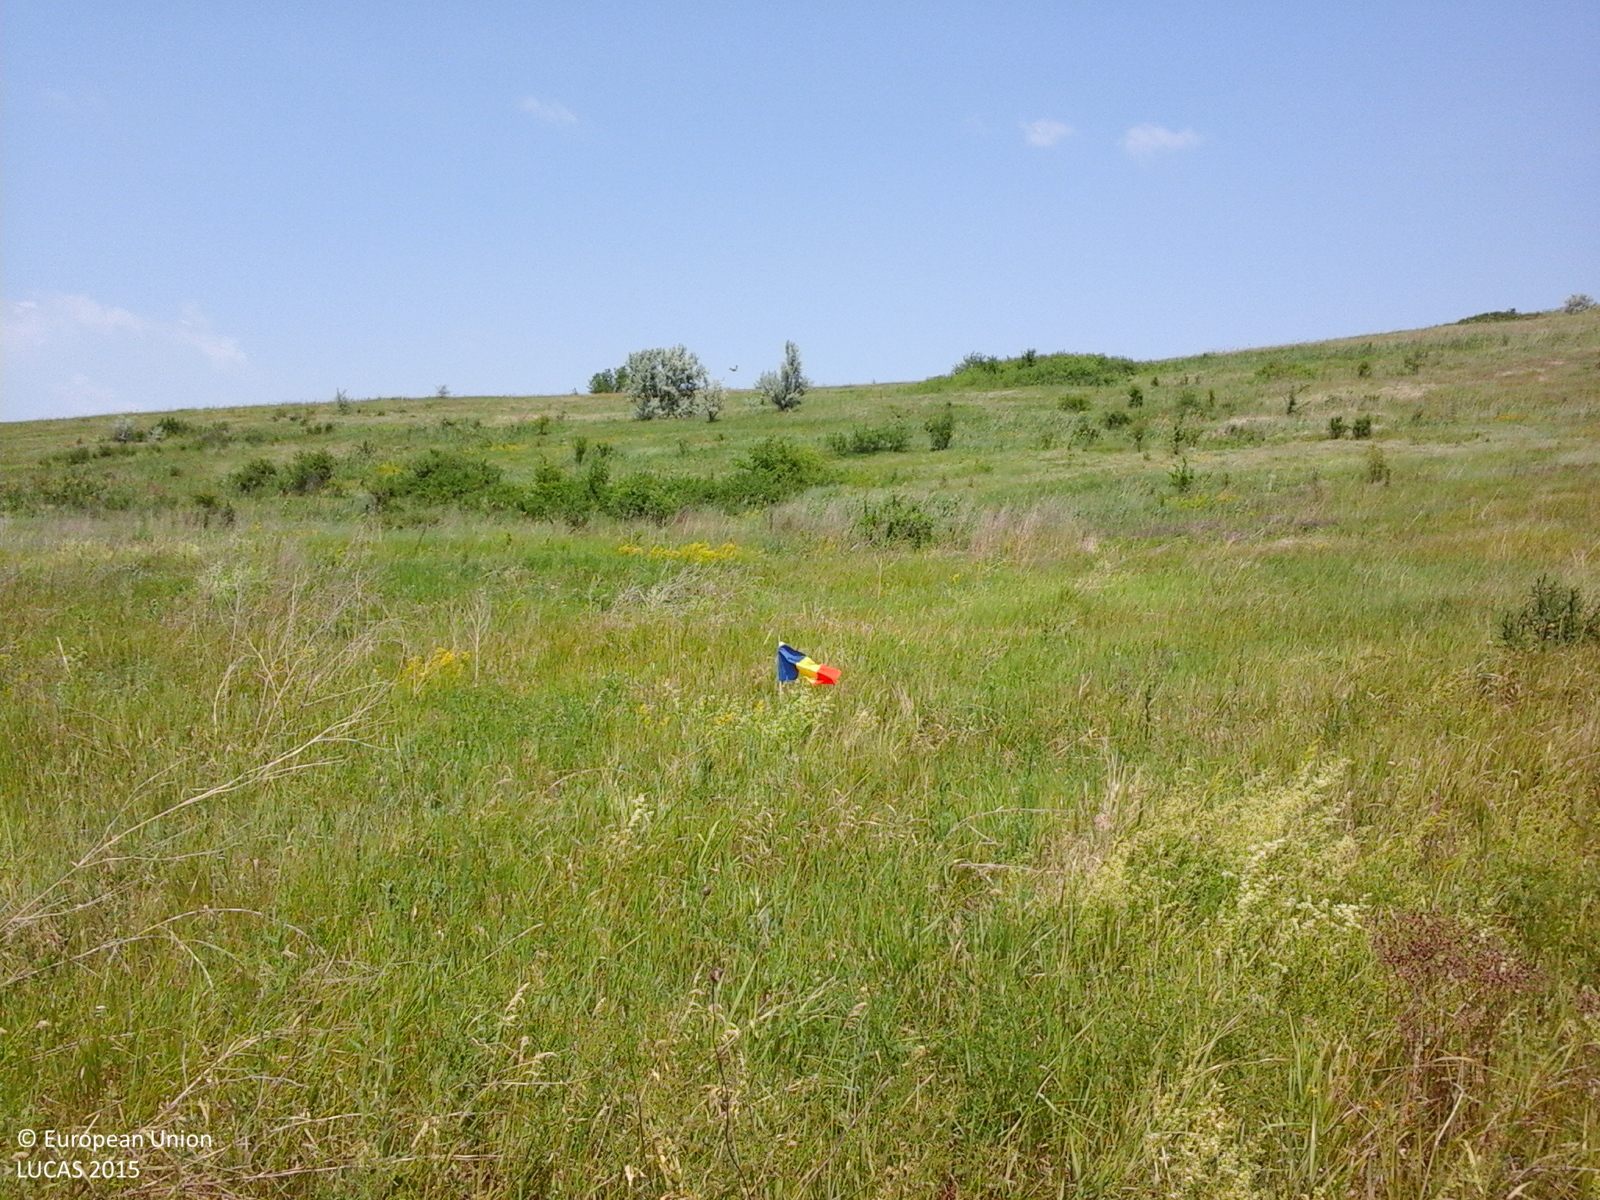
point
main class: Grassland
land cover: Grassland with sparse tree/shrub cover
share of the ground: > 75 %
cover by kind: herbaceous plants 90 %, broadleaved forest trees 5 %, shrubs 5 %
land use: Agriculture (excluding fallow land and kitchen gardens)
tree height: < 5 m
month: June
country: RO
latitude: 47.2441
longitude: 27.6526
